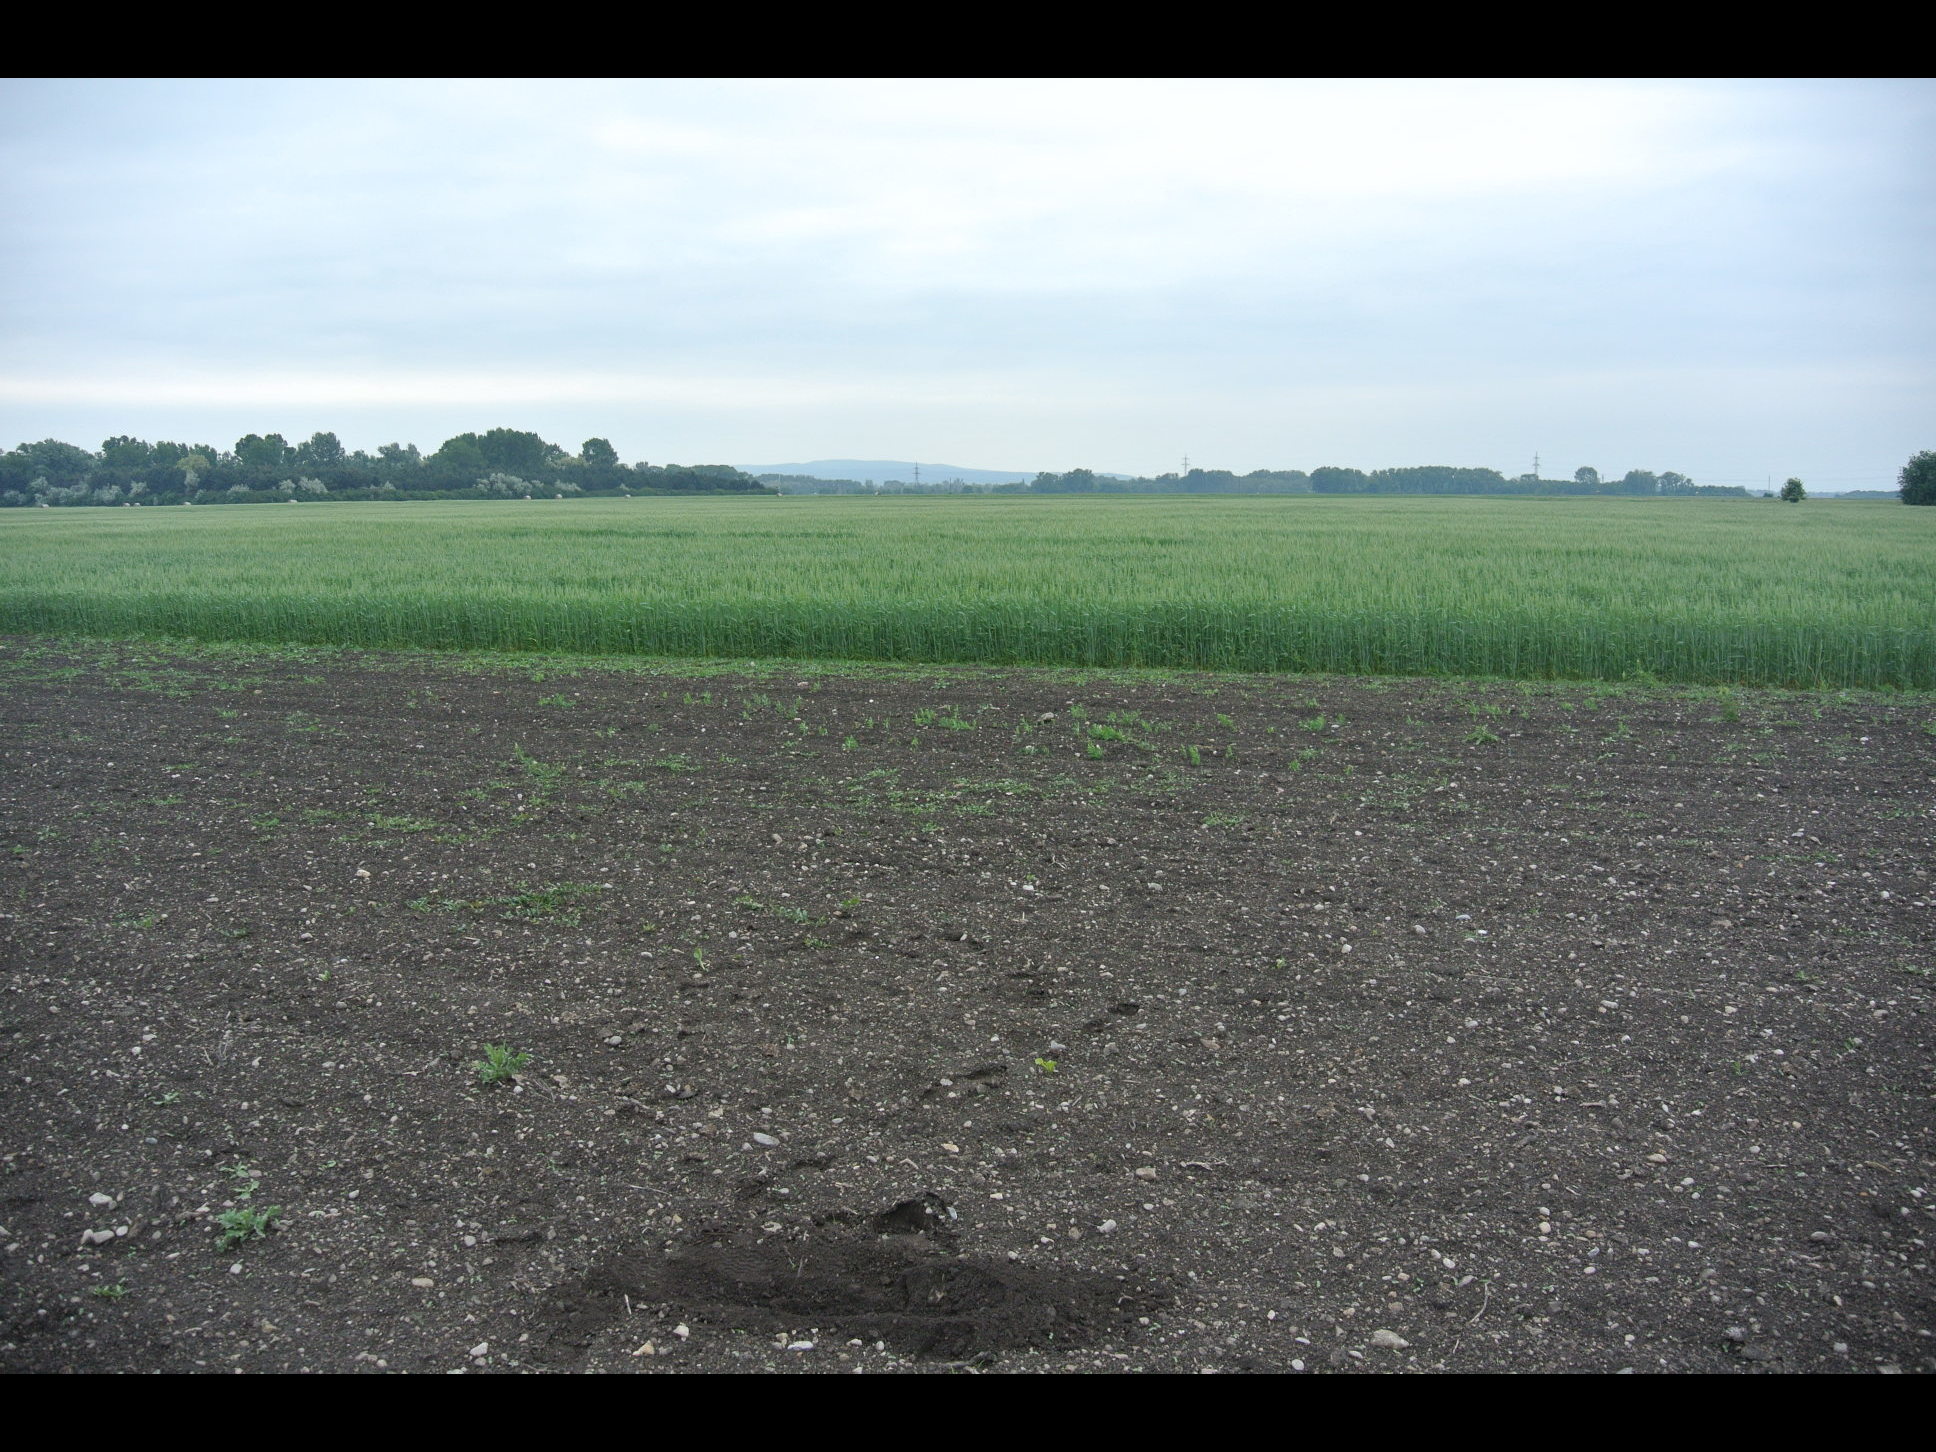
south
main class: Cropland
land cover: Sunflower
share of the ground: > 75 %
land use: Agriculture (excluding fallow land and kitchen gardens)
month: May
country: AT
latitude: 47.9953
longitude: 16.5047
